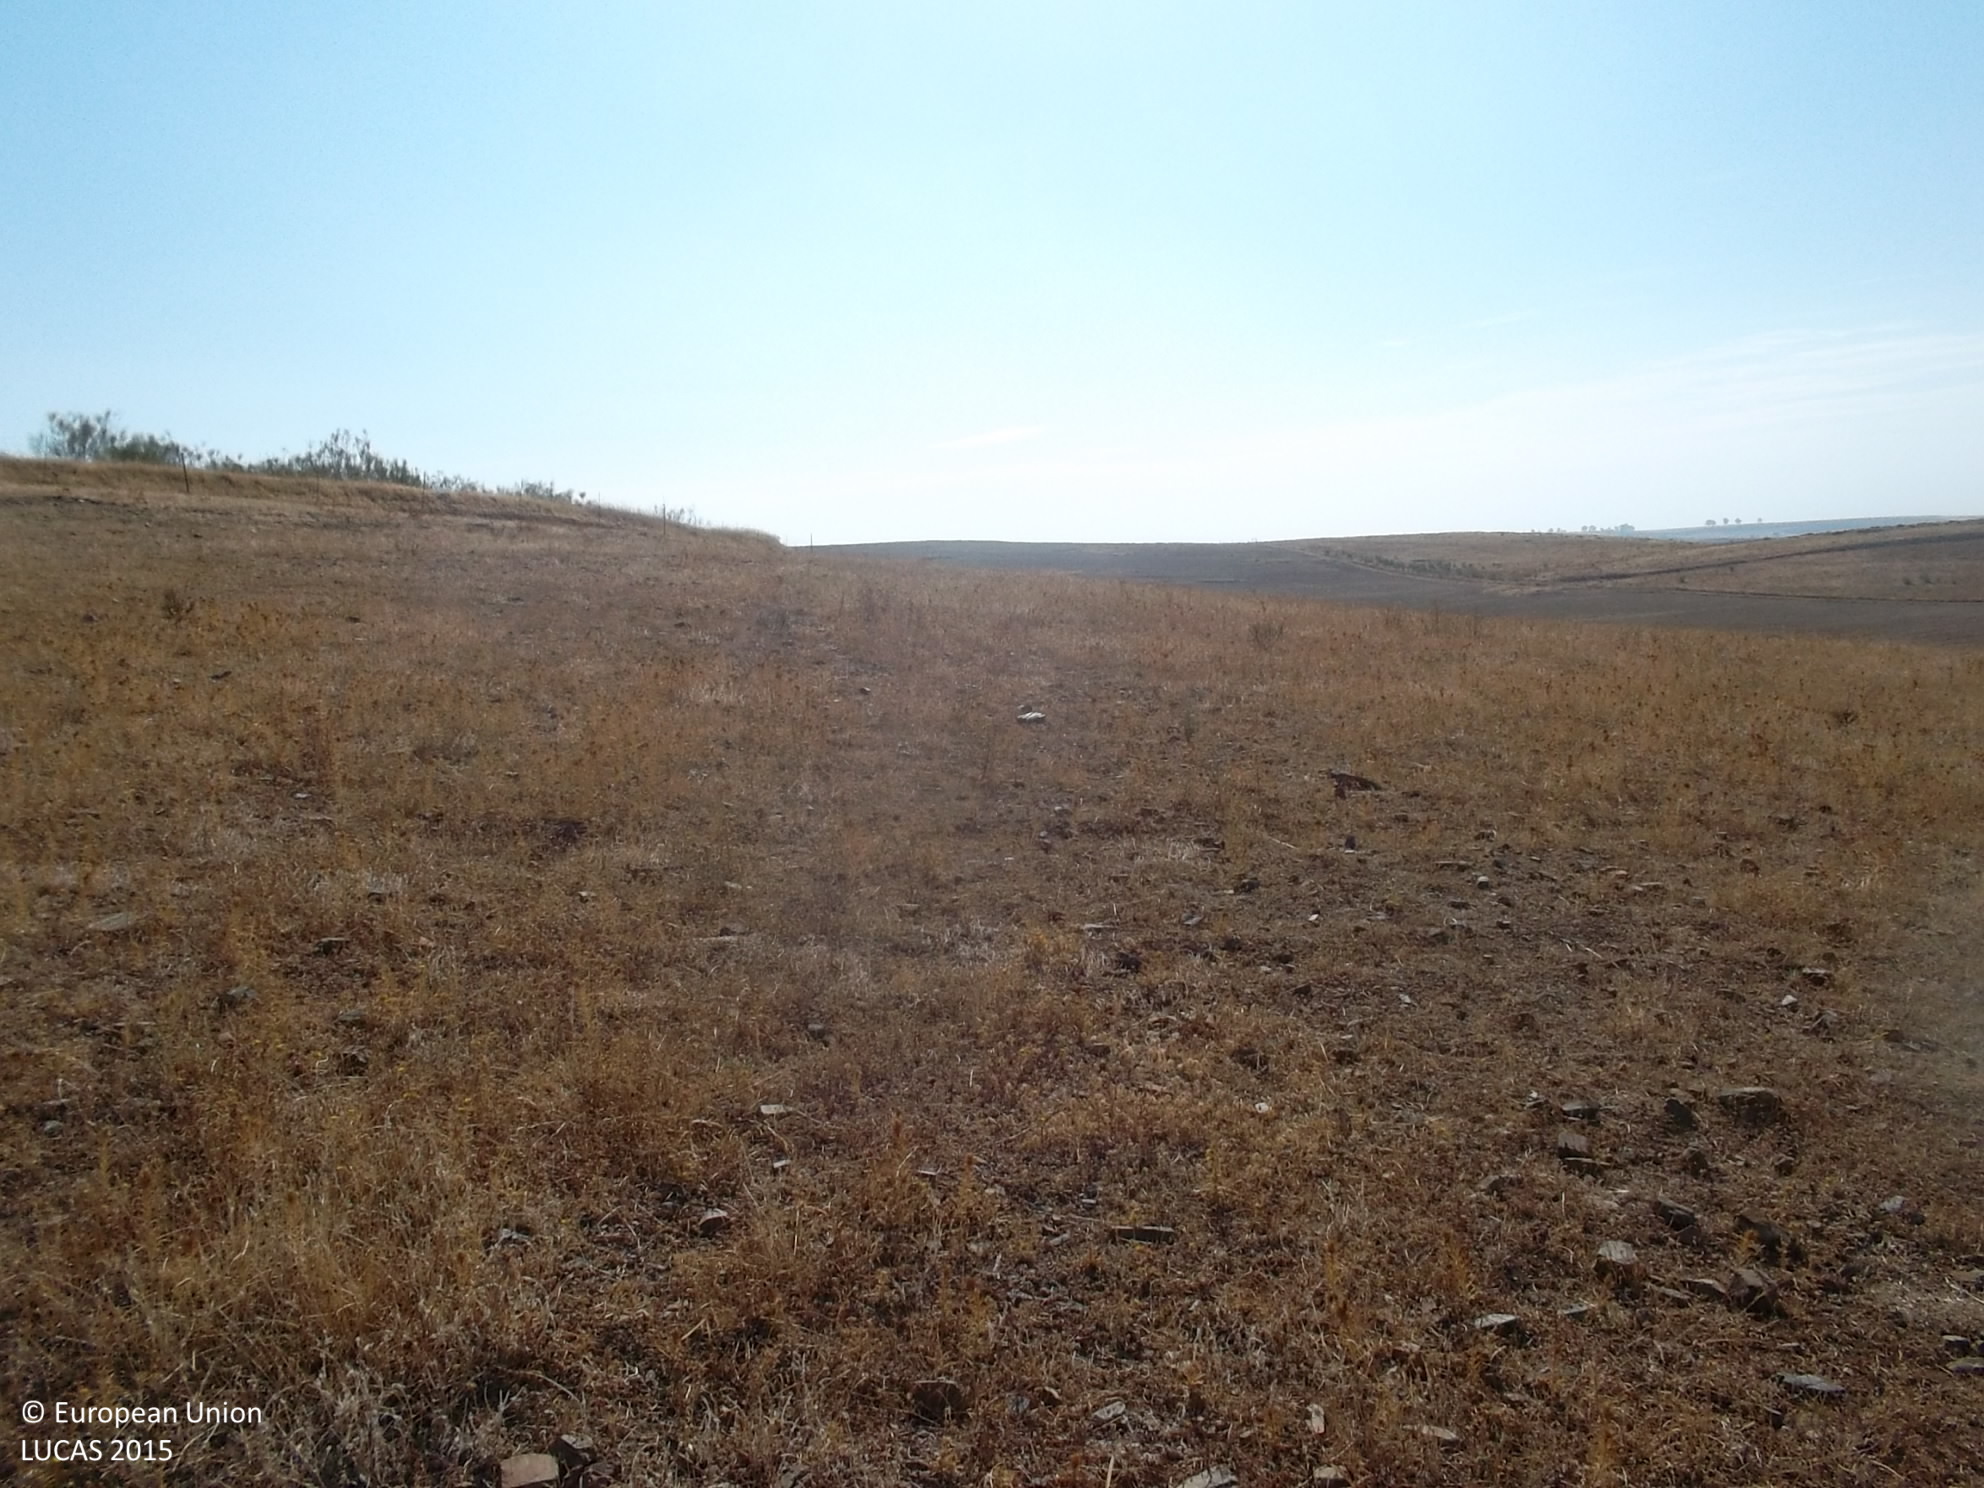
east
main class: Grassland
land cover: Spontaneously vegetated surfaces
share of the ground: > 75 %
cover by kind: herbaceous plants 100 %
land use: Fallow land
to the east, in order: Spontaneously vegetated surfaces; Grass margins; Fences; Spontaneously vegetated surfaces
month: September
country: ES
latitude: 38.2442
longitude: -6.3275
